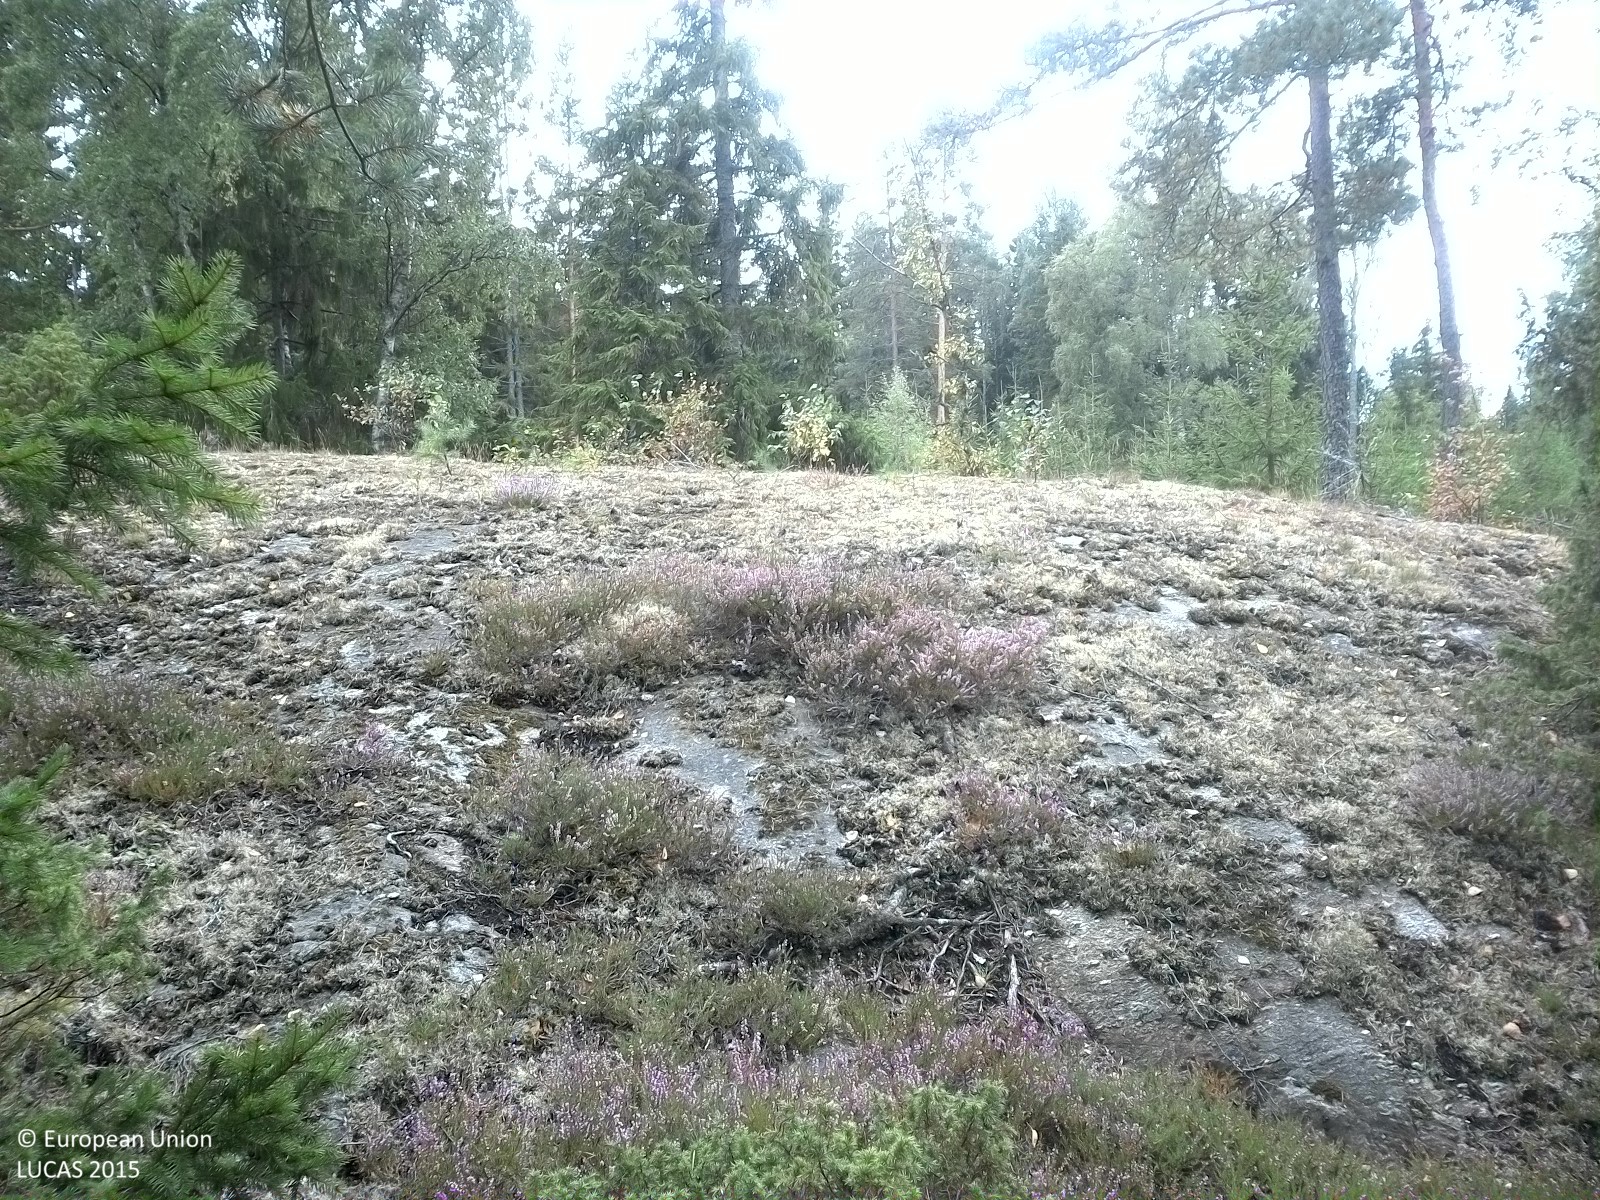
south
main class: Shrubland
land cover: Shrubland with sparse tree cover
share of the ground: 50 - 75 %
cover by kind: shrubs 55 %, lichens and mosses 20 %, coniferous forest trees 5 %
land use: Semi-natural and natural areas not in use
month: August
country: SE
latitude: 59.0070
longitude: 15.5468
